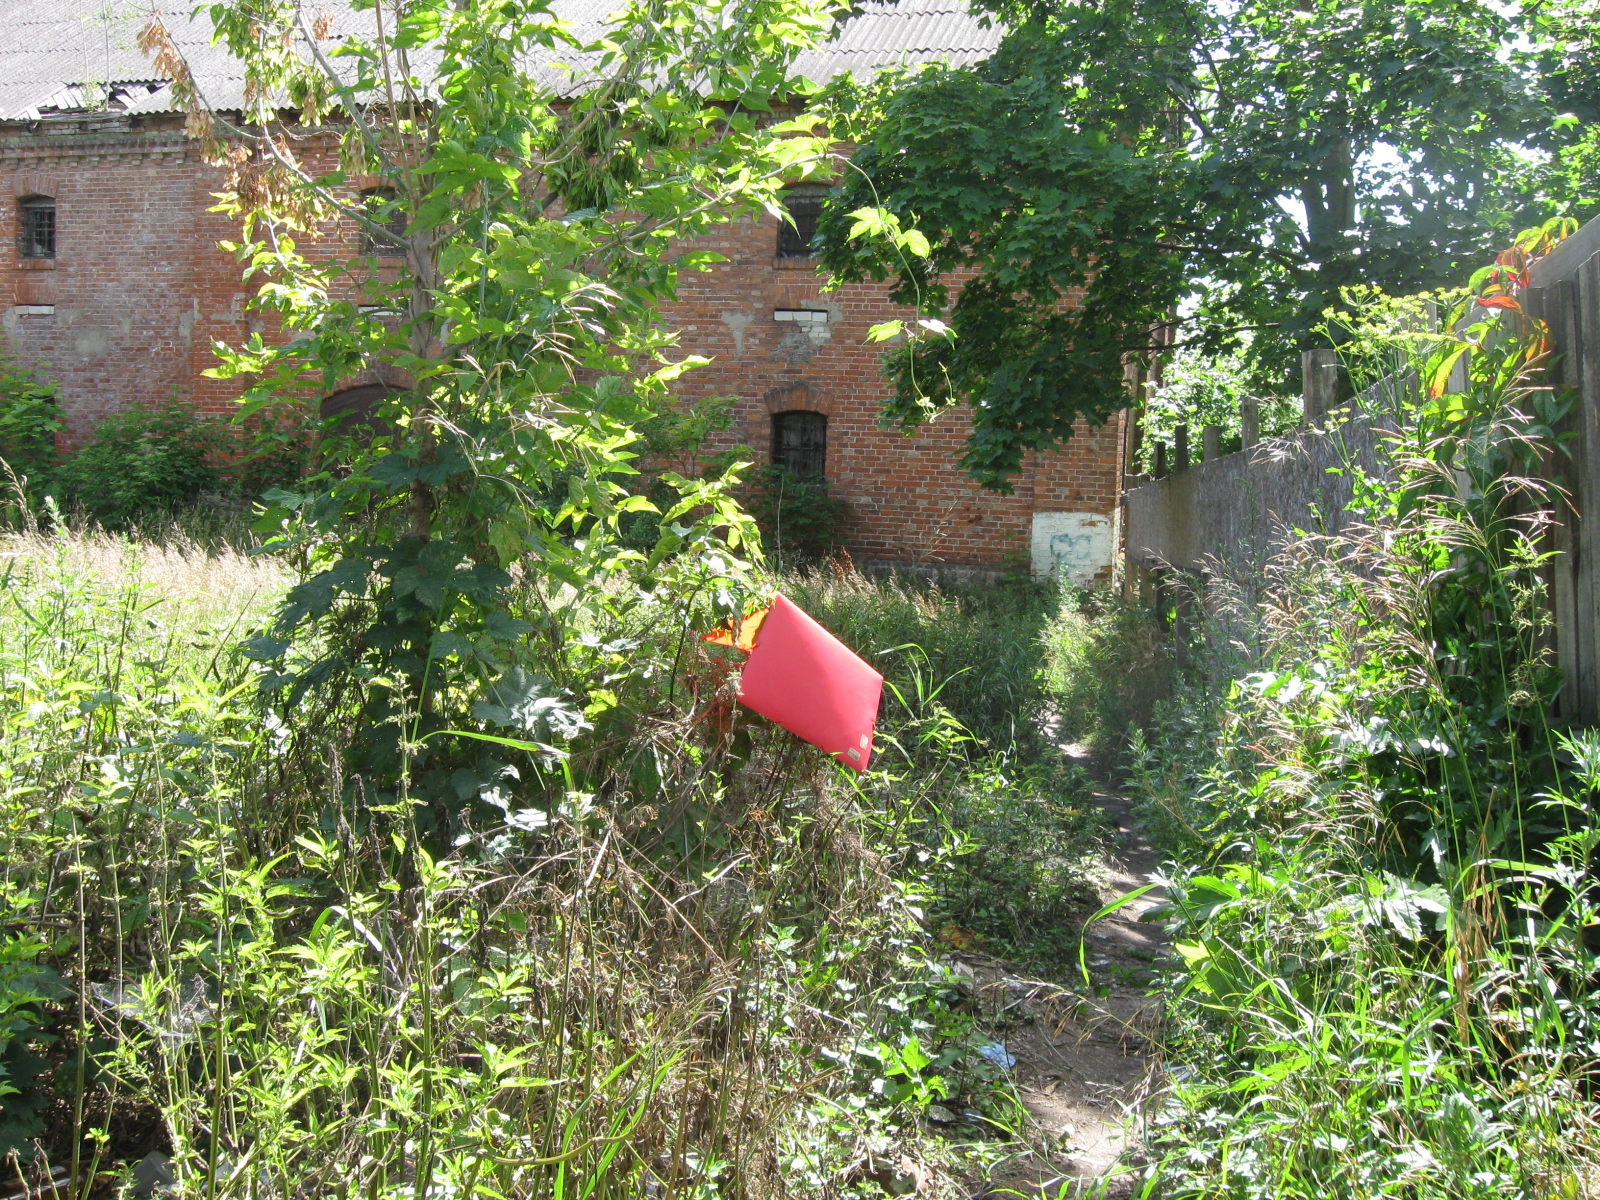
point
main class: Shrubland
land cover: Shrubland with sparse tree cover
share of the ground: > 75 %
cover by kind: herbaceous plants 45 %, shrubs 40 %, unconsolidated bare surface 10 %, broadleaved forest trees 5 %
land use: Semi-natural and natural areas not in use
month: July
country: LT
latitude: 54.8730
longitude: 23.9439
